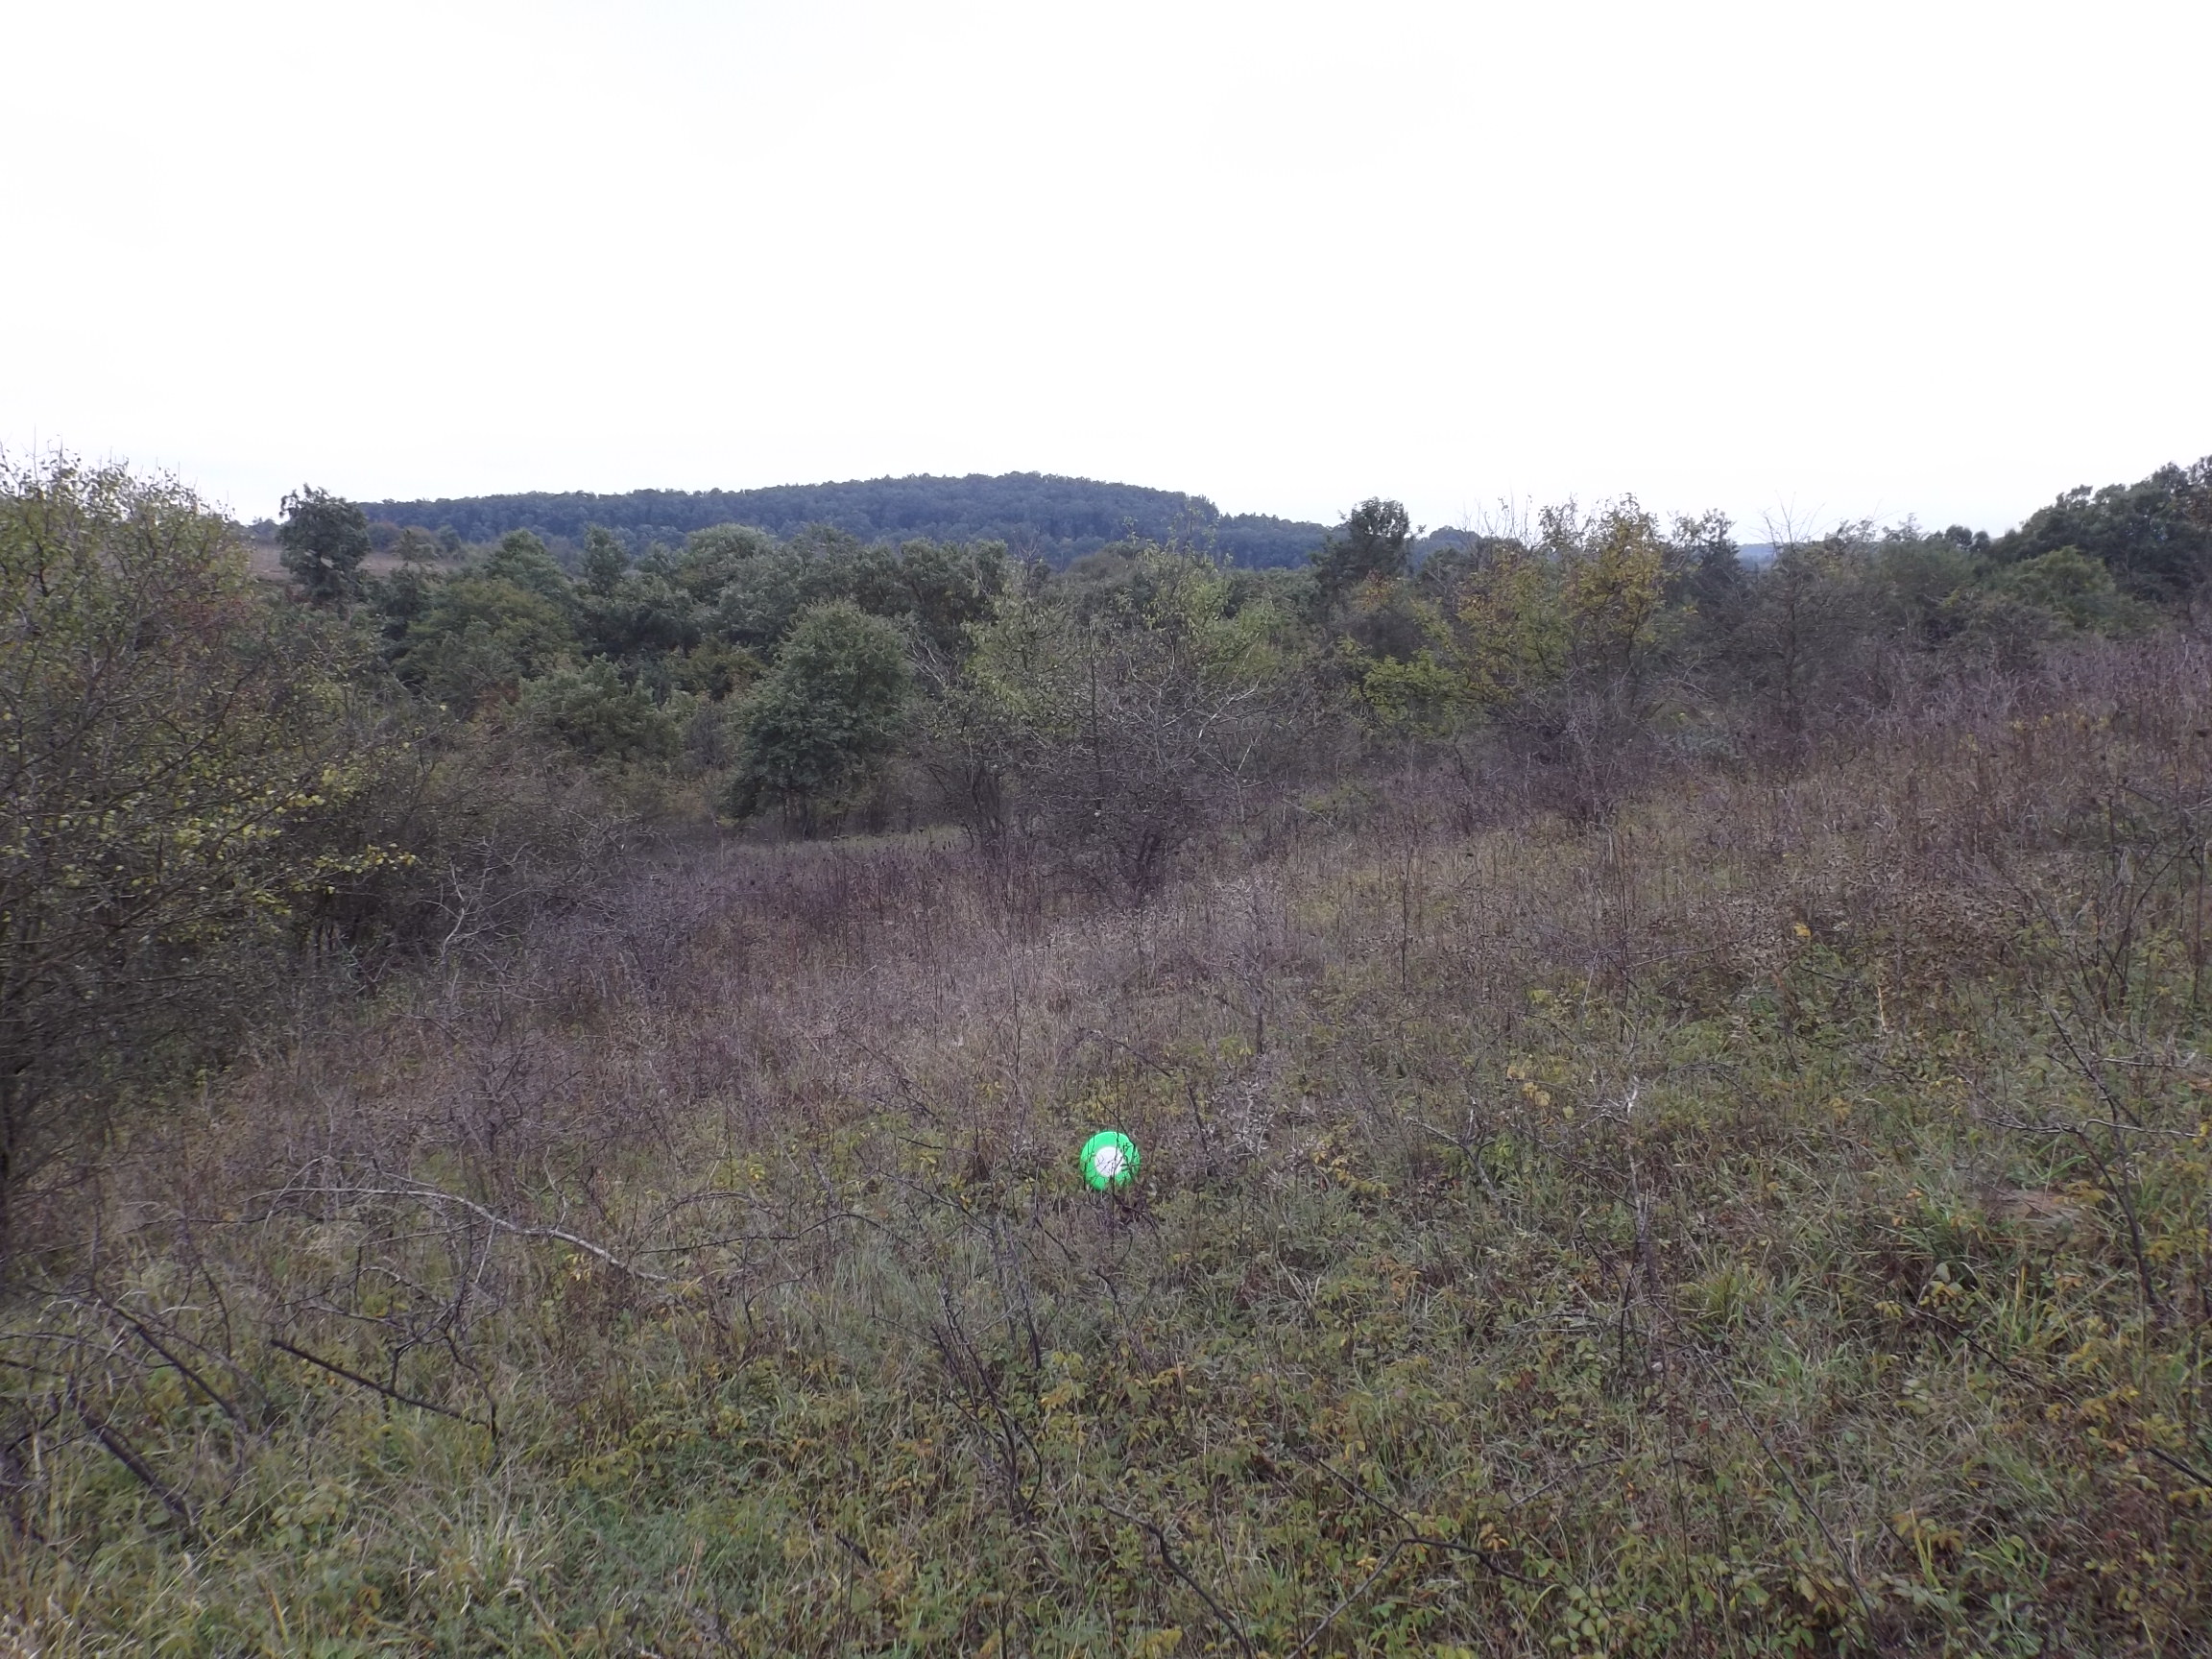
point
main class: Shrubland
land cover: Shrubland with sparse tree cover
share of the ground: 50 - 75 %
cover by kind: shrubs 55 %, herbaceous plants 40 %, broadleaved forest trees 5 %
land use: Semi-natural and natural areas not in use
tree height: > 5 m
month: October
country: BG
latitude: 43.0320
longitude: 27.1884
